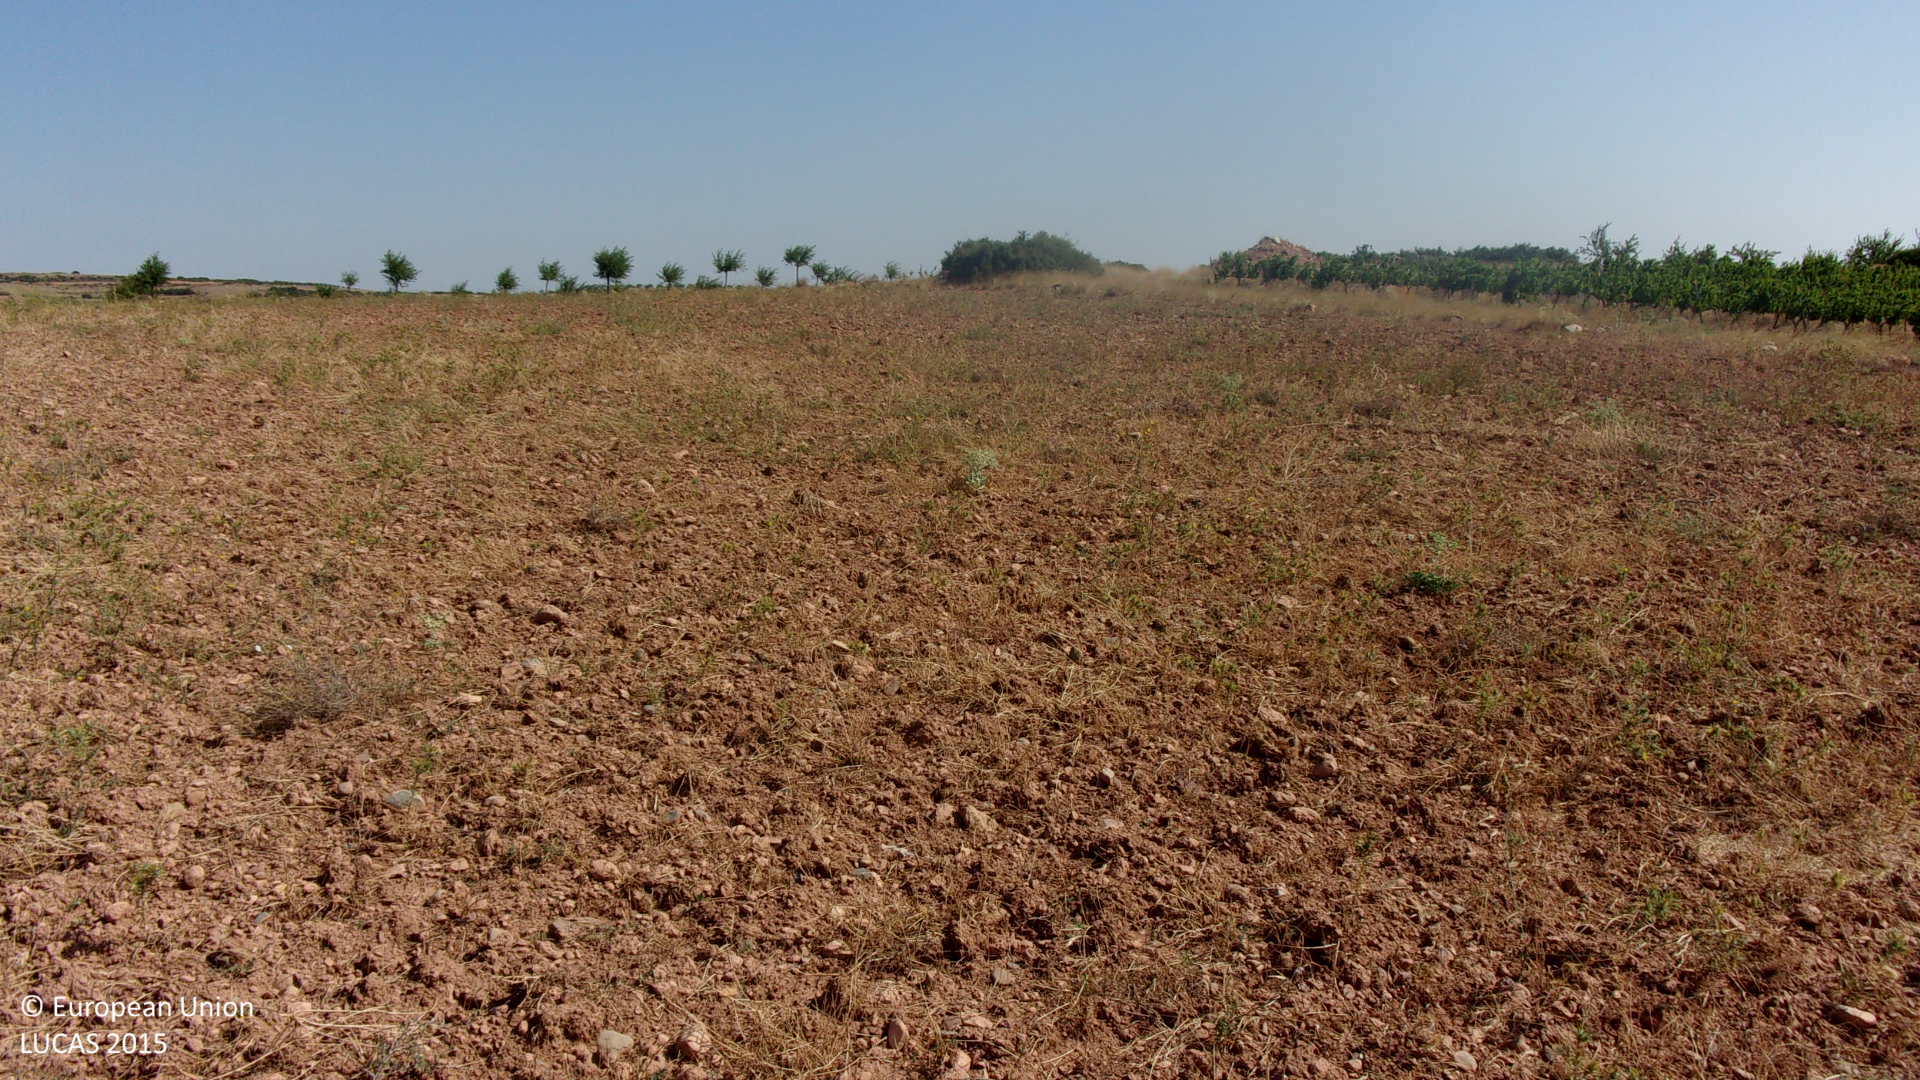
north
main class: Grassland
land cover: Spontaneously vegetated surfaces
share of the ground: 25 - 50 %
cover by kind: unconsolidated bare surface 65 %, herbaceous plants 35 %
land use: Fallow land
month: July
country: ES
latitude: 41.6744
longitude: -1.4499
